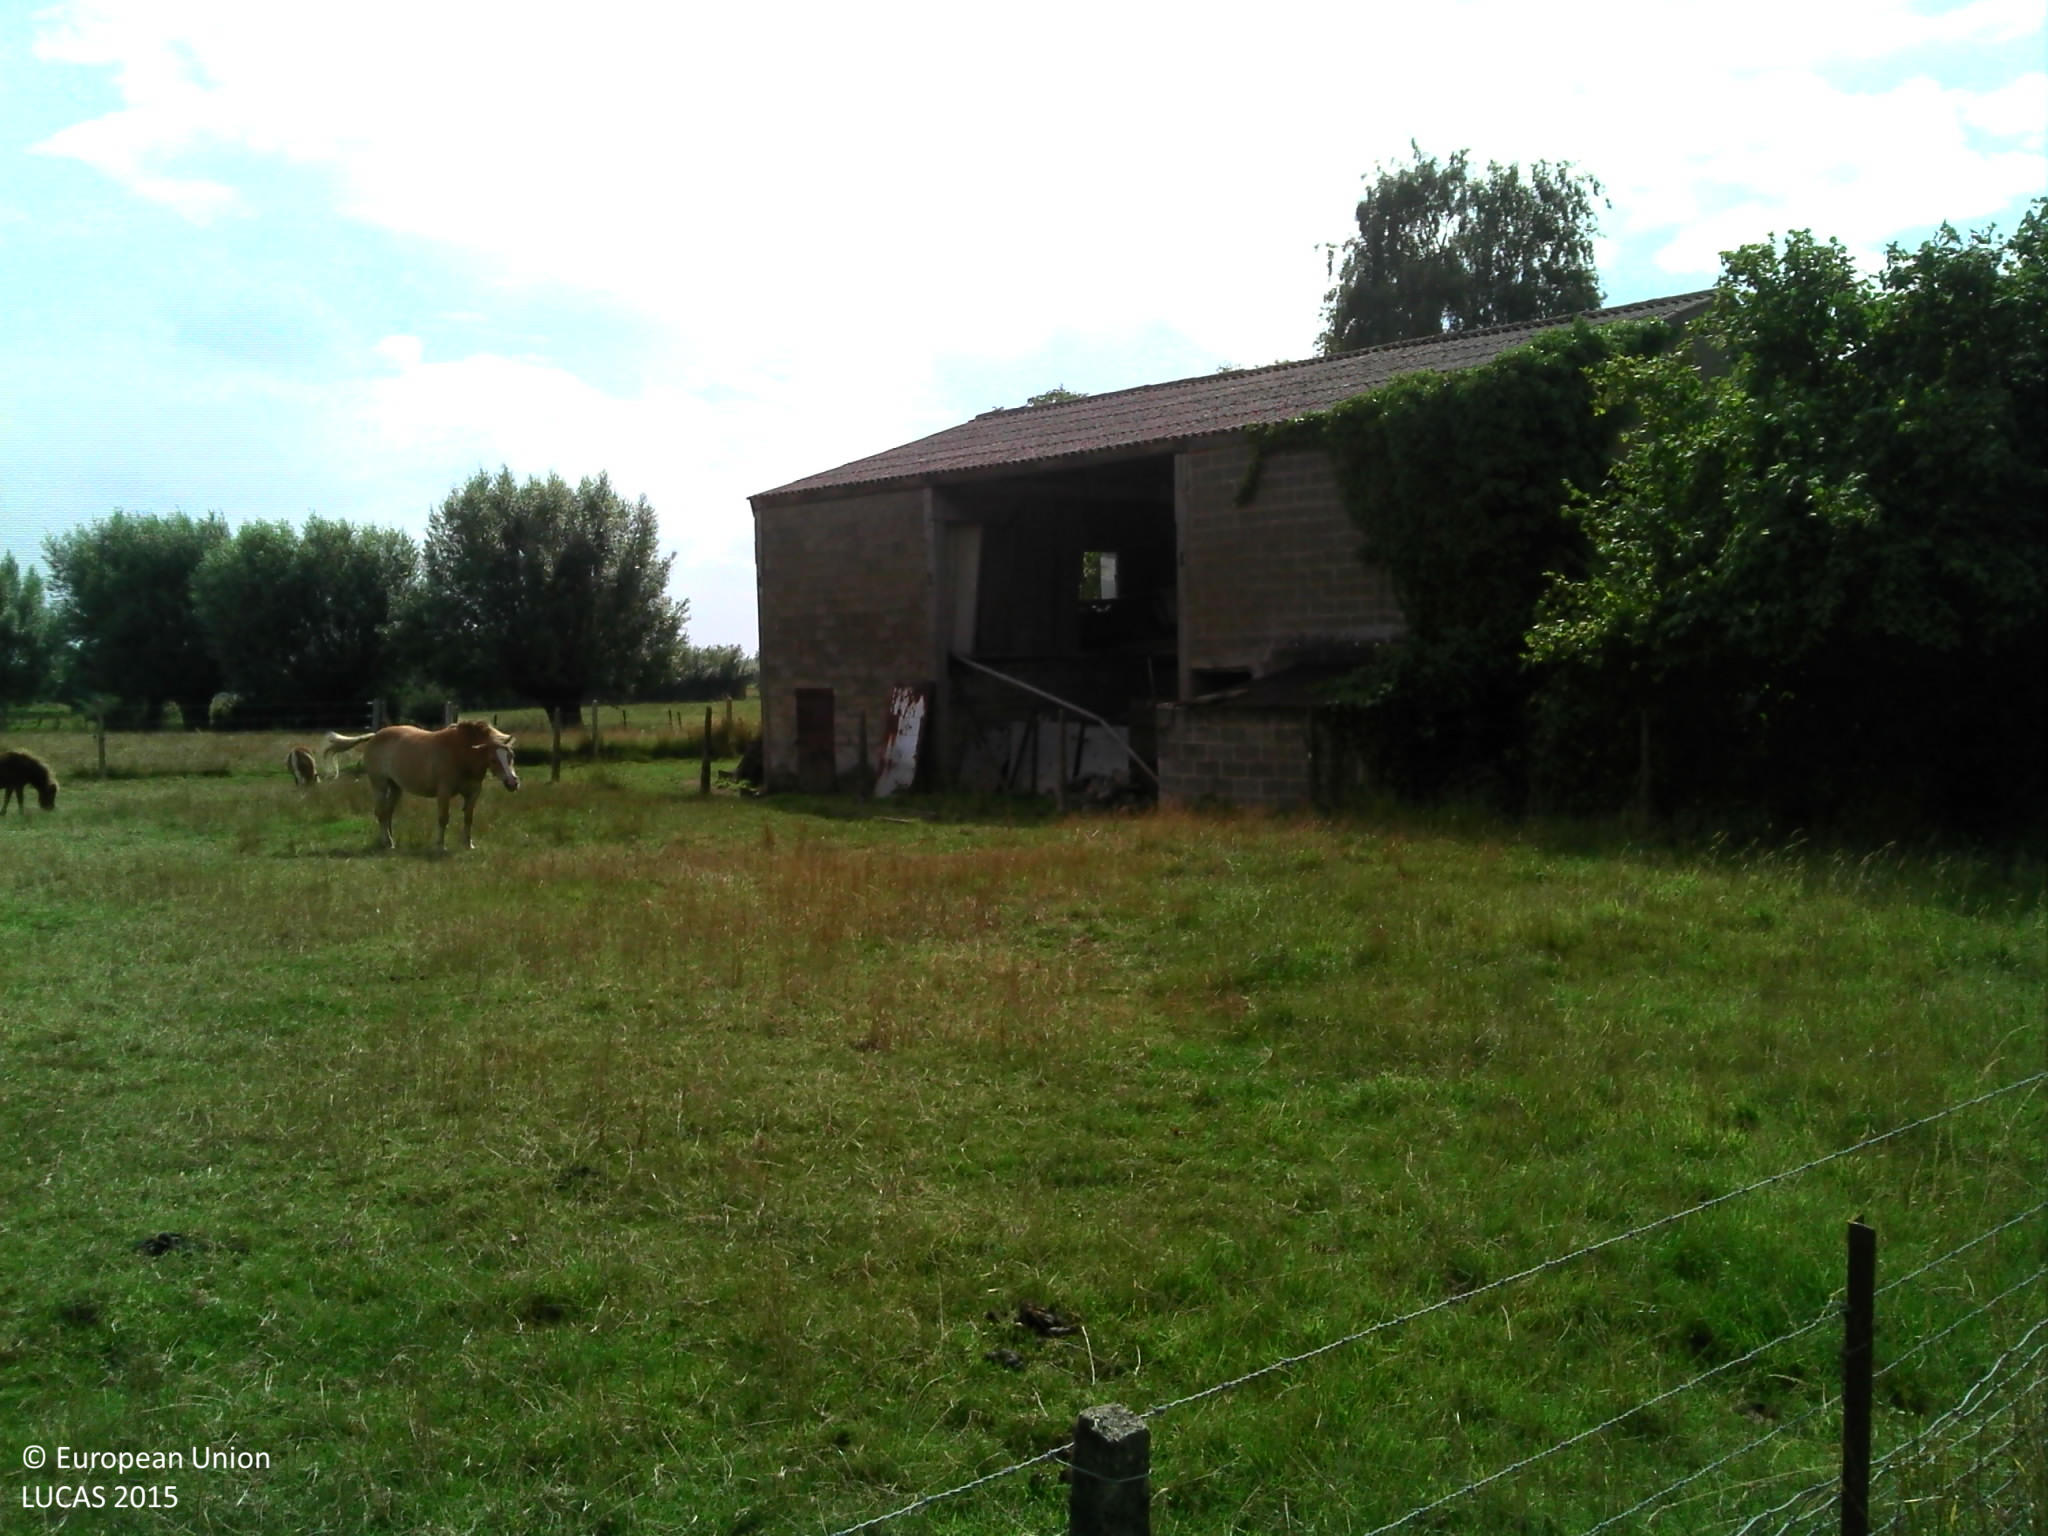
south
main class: Grassland
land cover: Grassland without tree/shrub cover
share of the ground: > 75 %
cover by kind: herbaceous plants 100 %
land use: Agriculture (excluding fallow land and kitchen gardens)
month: August
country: BE
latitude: 50.9011
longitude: 2.8939
